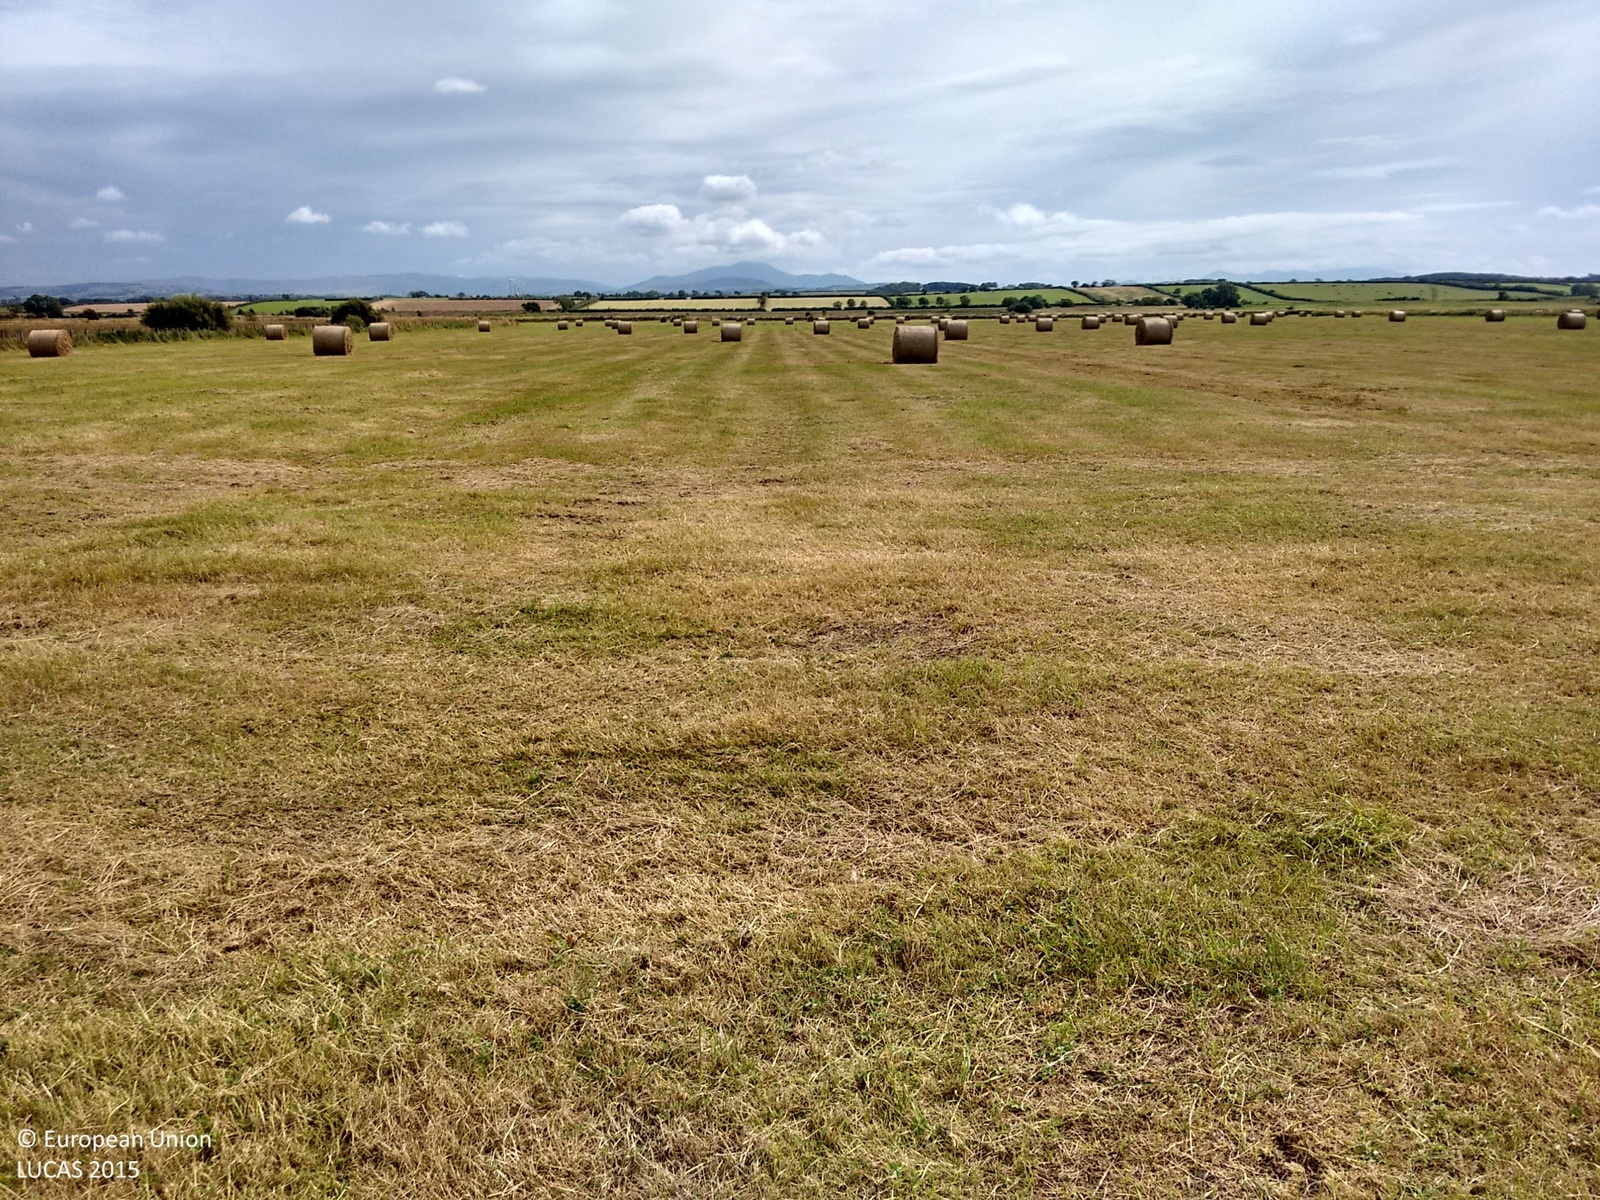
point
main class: Grassland
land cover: Grassland without tree/shrub cover
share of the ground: > 75 %
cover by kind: herbaceous plants 100 %
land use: Agriculture (excluding fallow land and kitchen gardens)
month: August
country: GB
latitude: 54.8140
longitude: -3.3201
